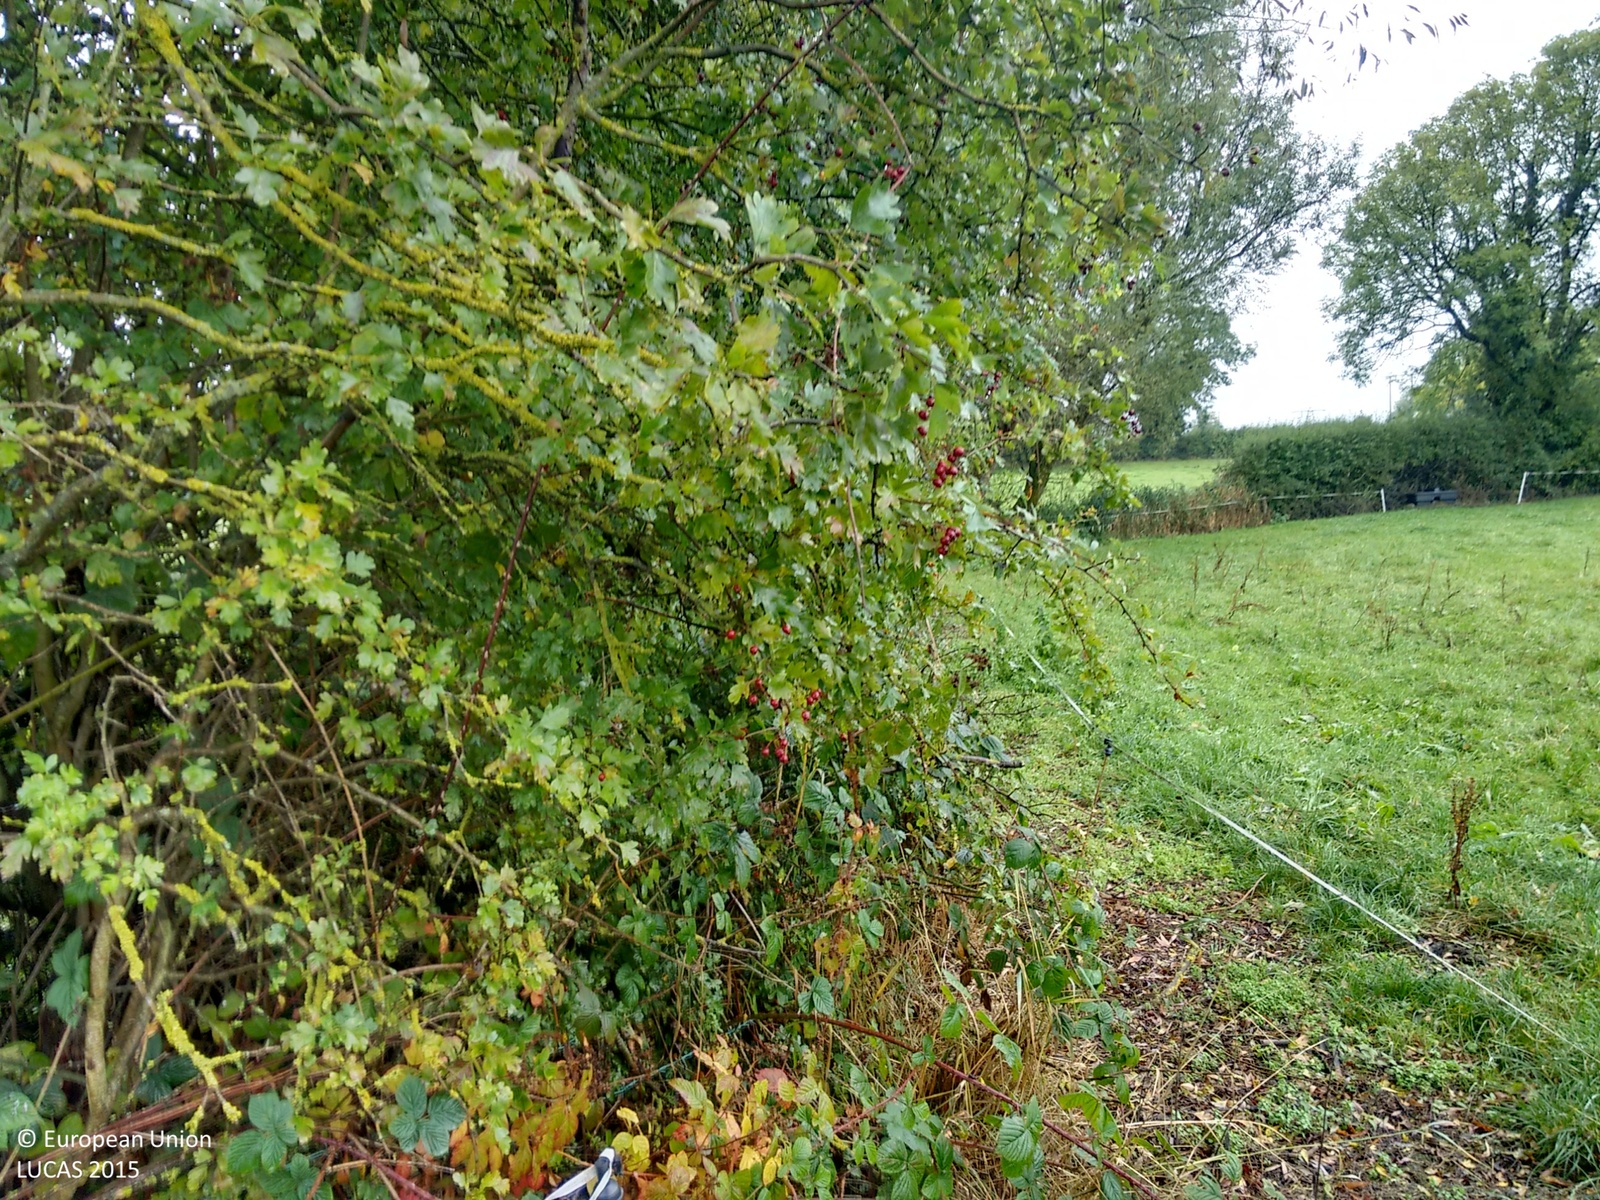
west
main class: Grassland
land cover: Grassland without tree/shrub cover
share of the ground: > 75 %
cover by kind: herbaceous plants 100 %
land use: Agriculture (excluding fallow land and kitchen gardens)
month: October
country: IE
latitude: 53.6799
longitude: -7.9940
